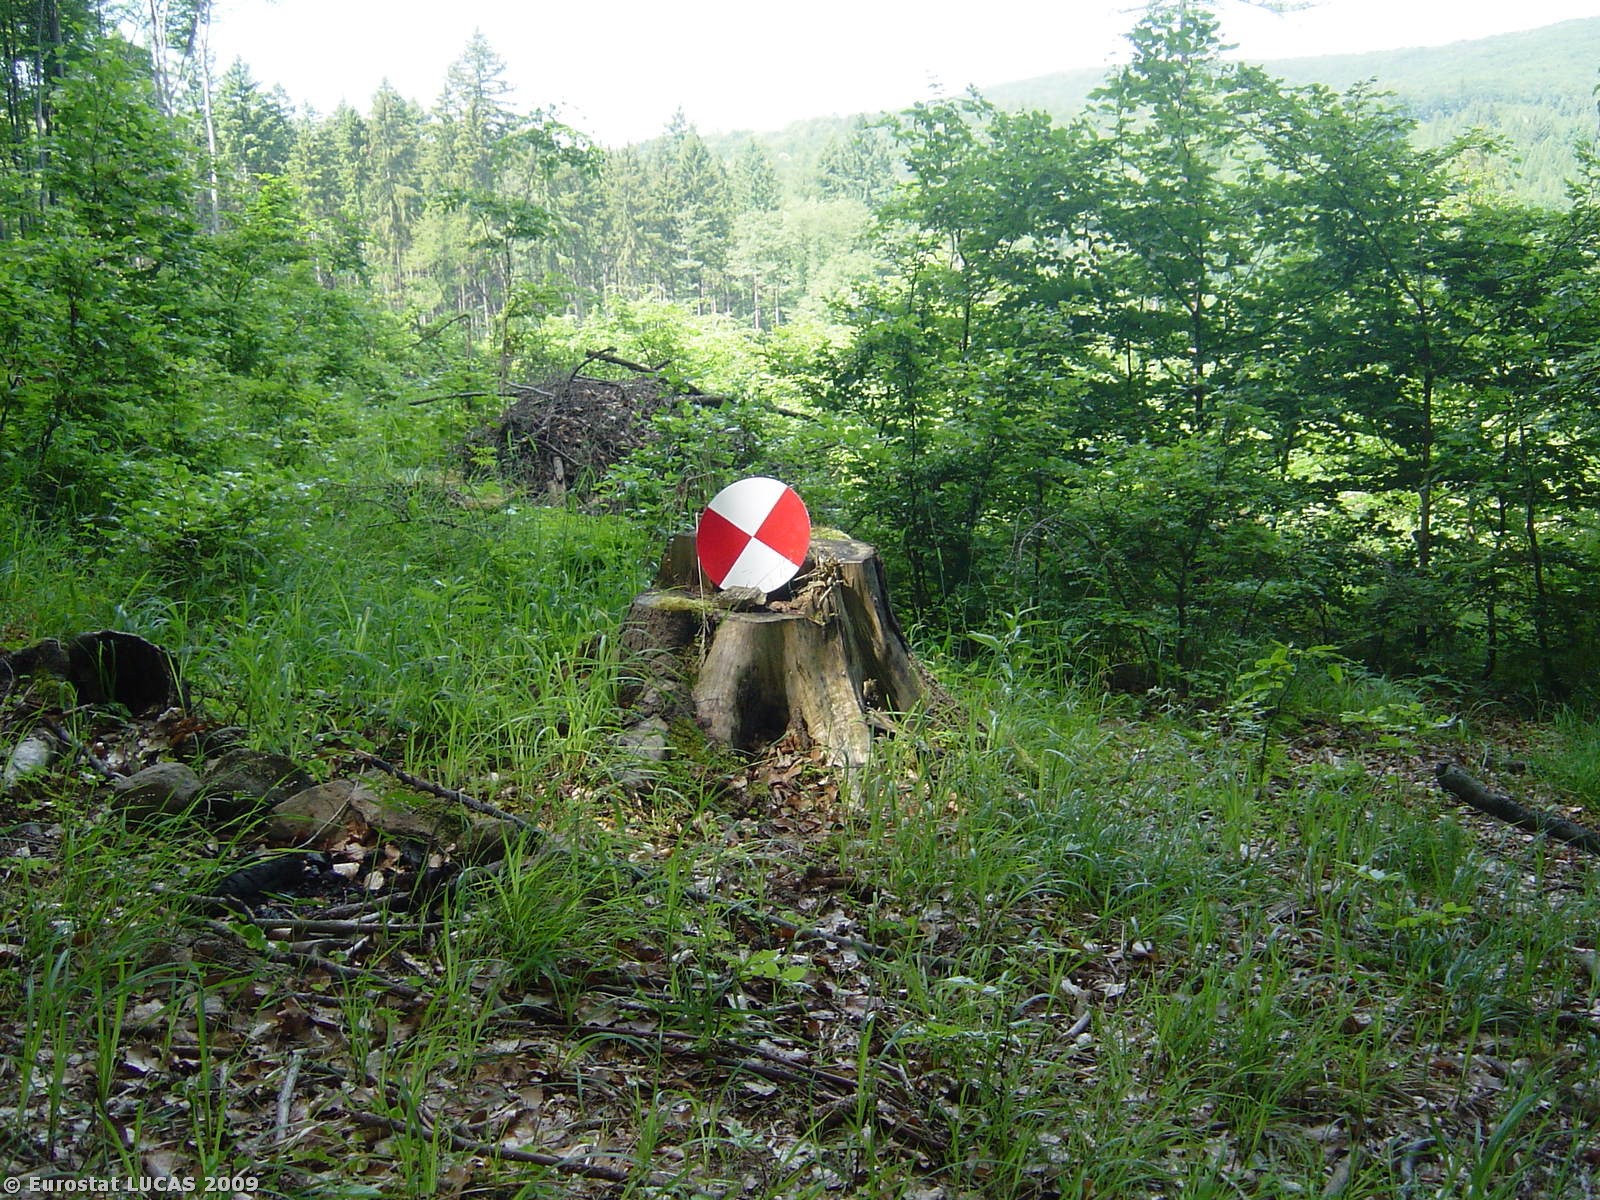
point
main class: Woodland
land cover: Mixed woodland
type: hemiboreal forest and nemoral coniferous forest and mixed broadleaved-coniferous forest
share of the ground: 50 - 75 %
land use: Forestry
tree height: > 5 m
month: May
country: CZ
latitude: 49.1060
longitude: 17.2290
